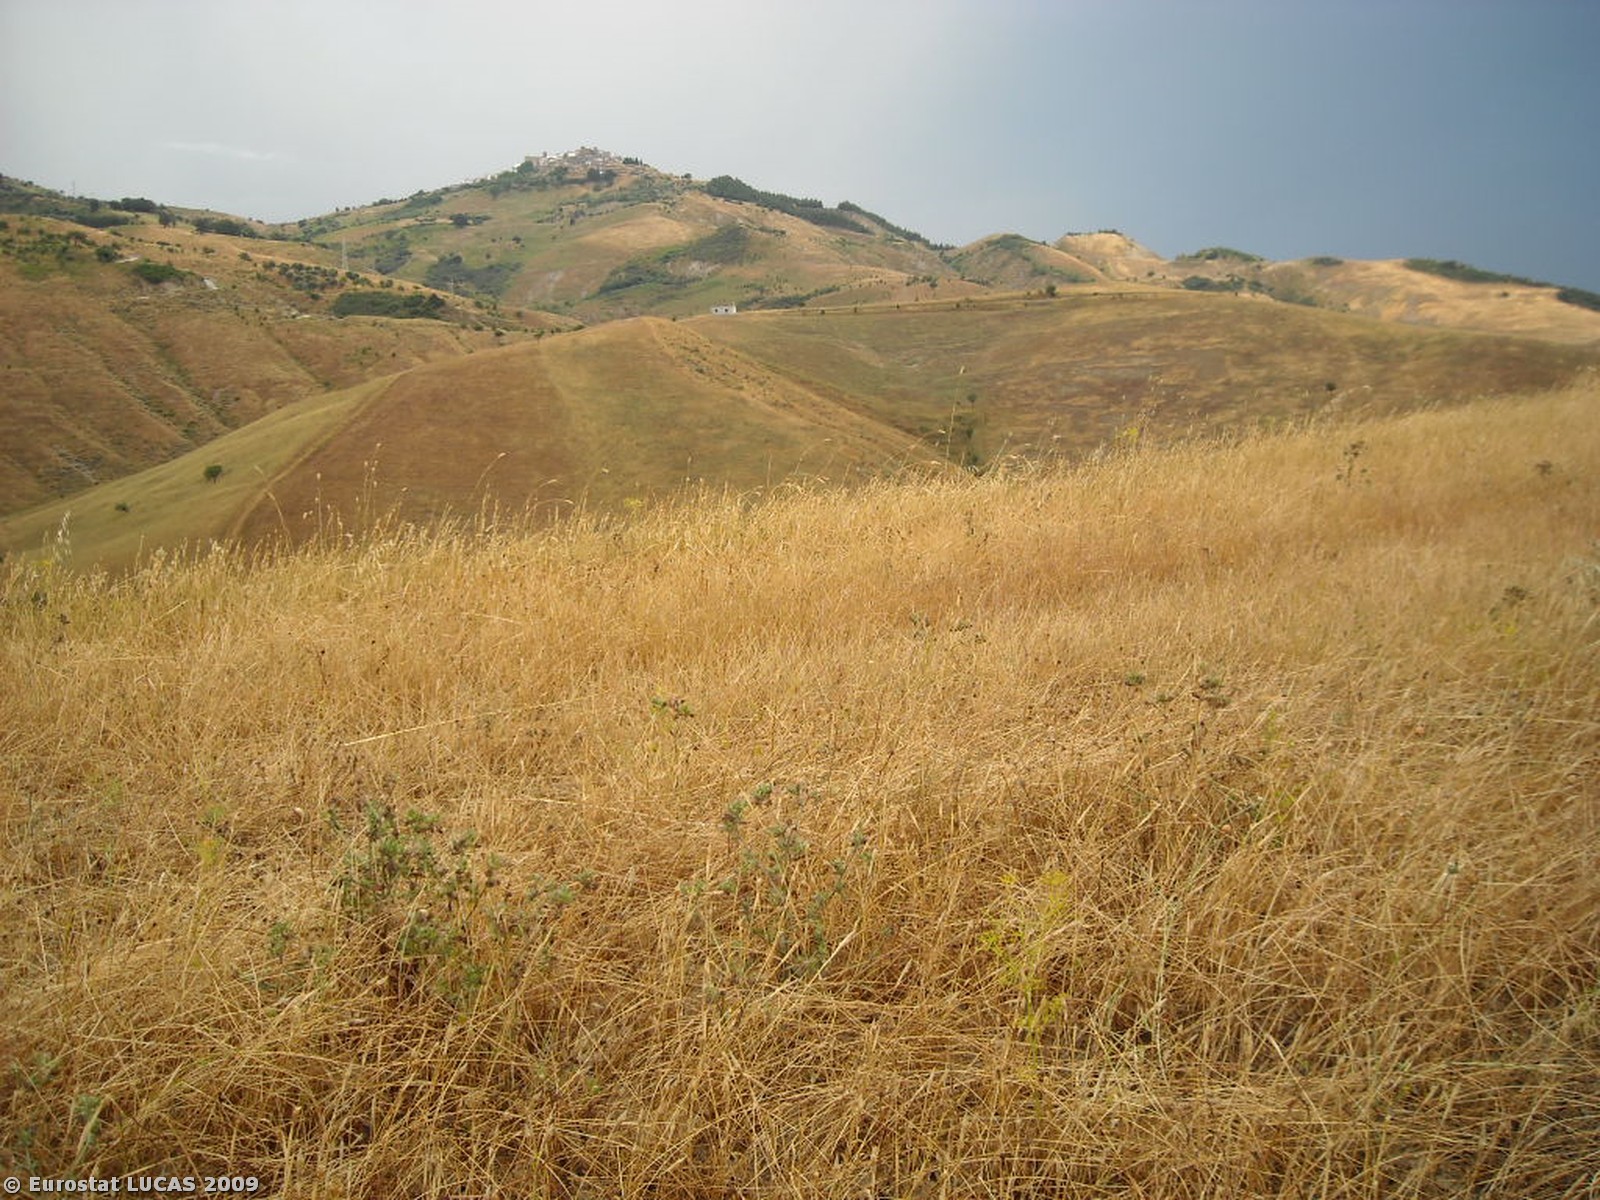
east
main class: Grassland
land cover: Spontaneously vegetated surfaces
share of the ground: > 75 %
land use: Fallow land
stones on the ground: < 10 %
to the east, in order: Spontaneously vegetated surfaces; Tracks; Common wheat; Spontaneously vegetated surfaces; Common wheat; Shrubland without tree cover; Inland running water; Shrubland without tree cover
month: June
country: IT
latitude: 40.5370
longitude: 16.2928
